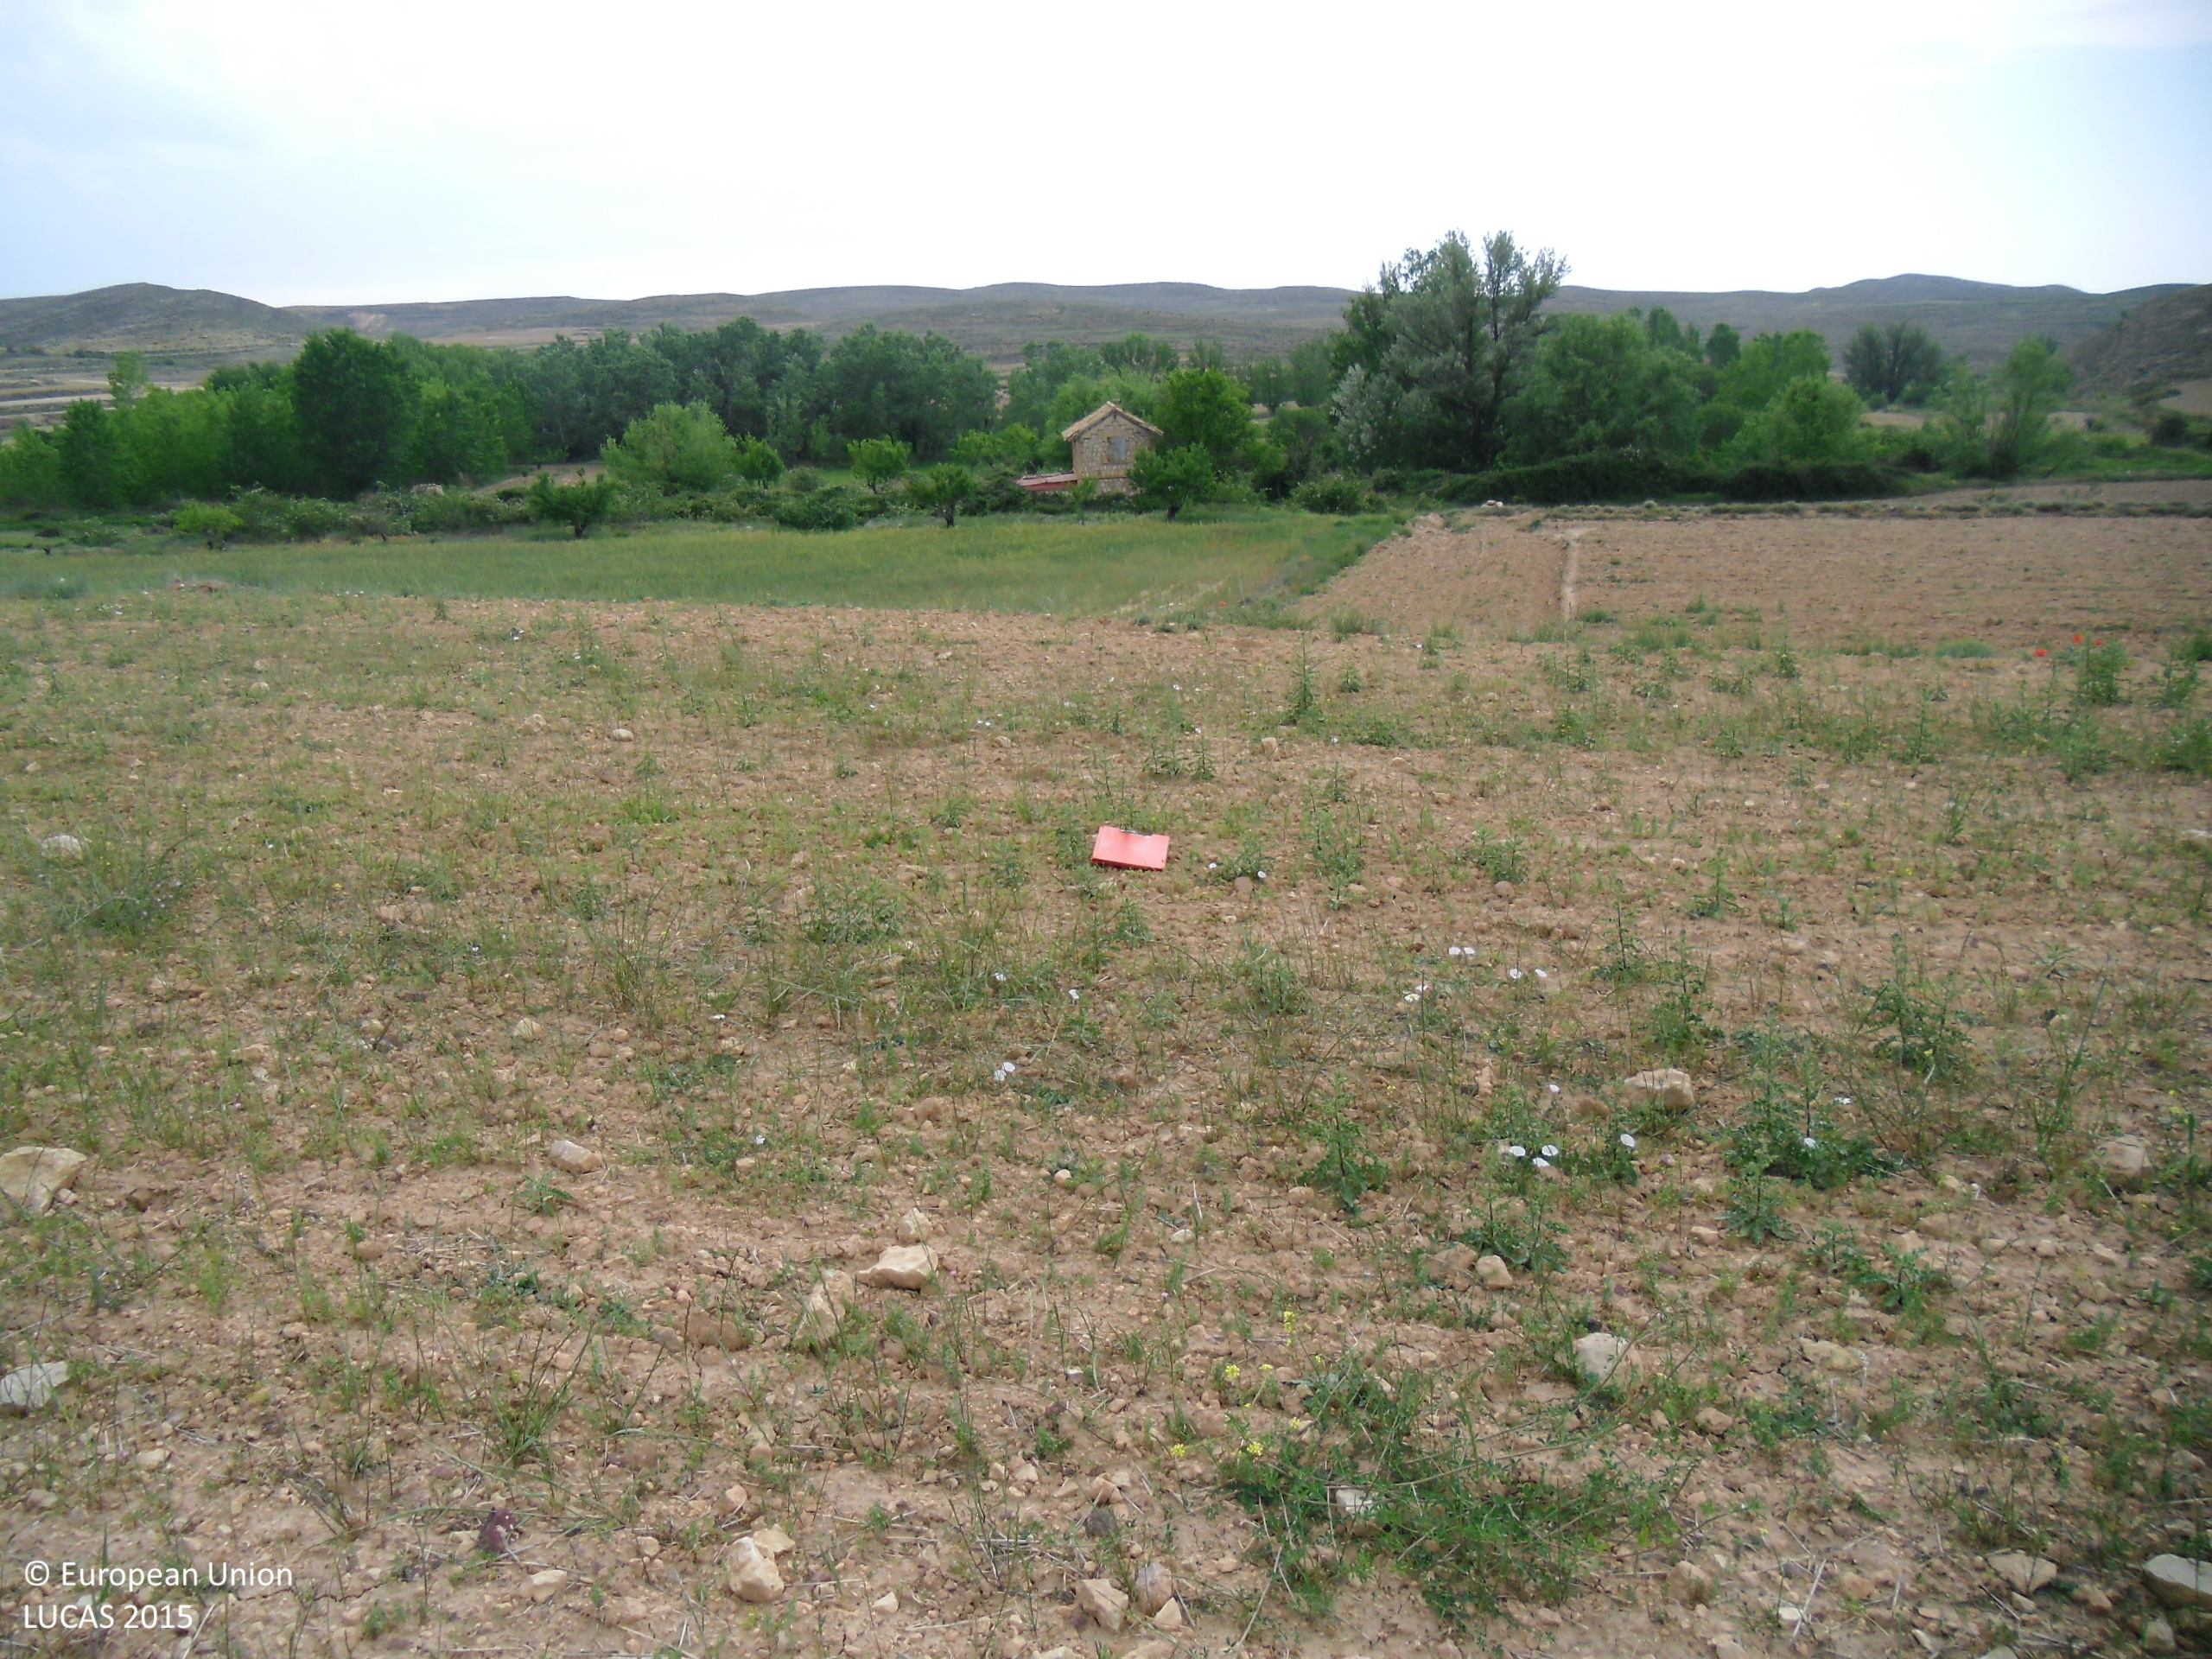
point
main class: Grassland
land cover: Spontaneously vegetated surfaces
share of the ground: 25 - 50 %
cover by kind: unconsolidated bare surface 60 %, herbaceous plants 40 %
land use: Fallow land
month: May
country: ES
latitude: 40.9953
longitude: -0.8450
